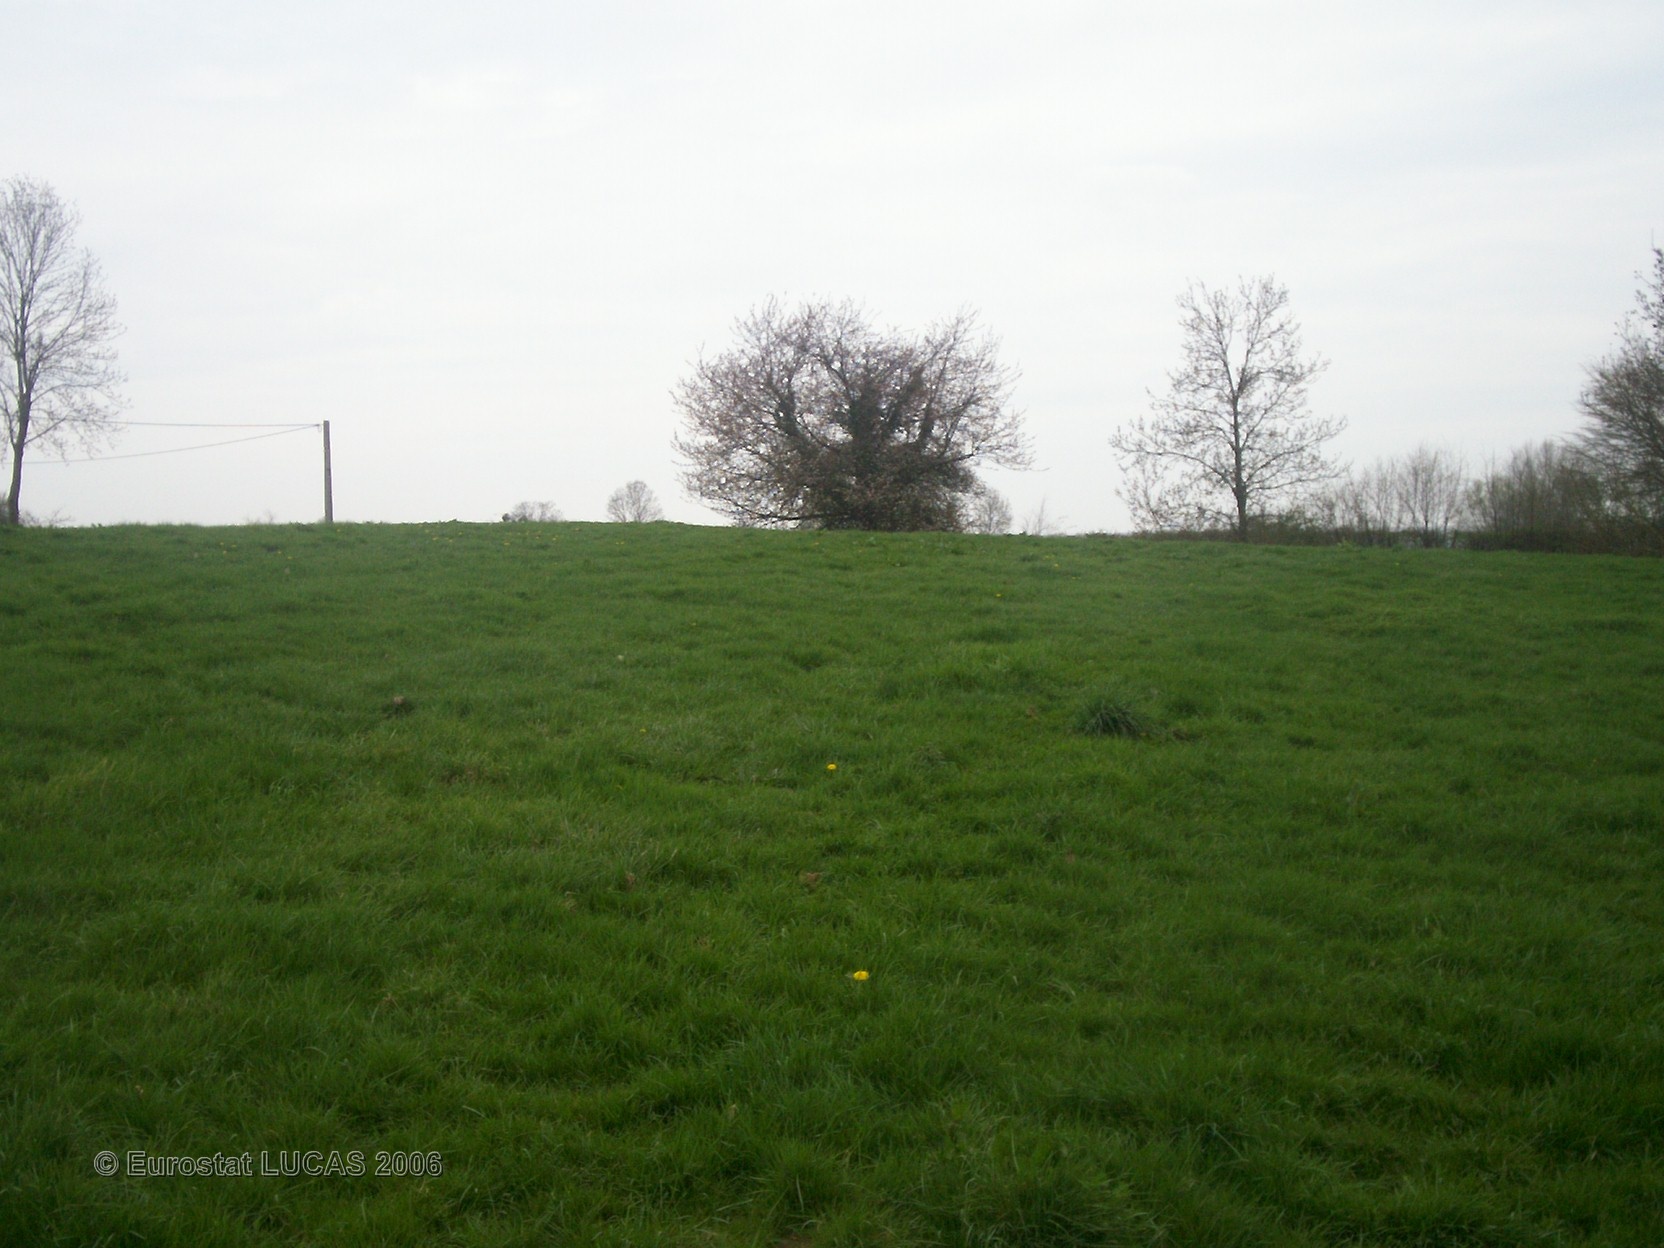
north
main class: Grassland
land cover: Grassland without tree/shrub cover
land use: Agriculture (excluding fallow land and kitchen gardens)
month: April
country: FR
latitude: 50.1205
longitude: 3.7416
